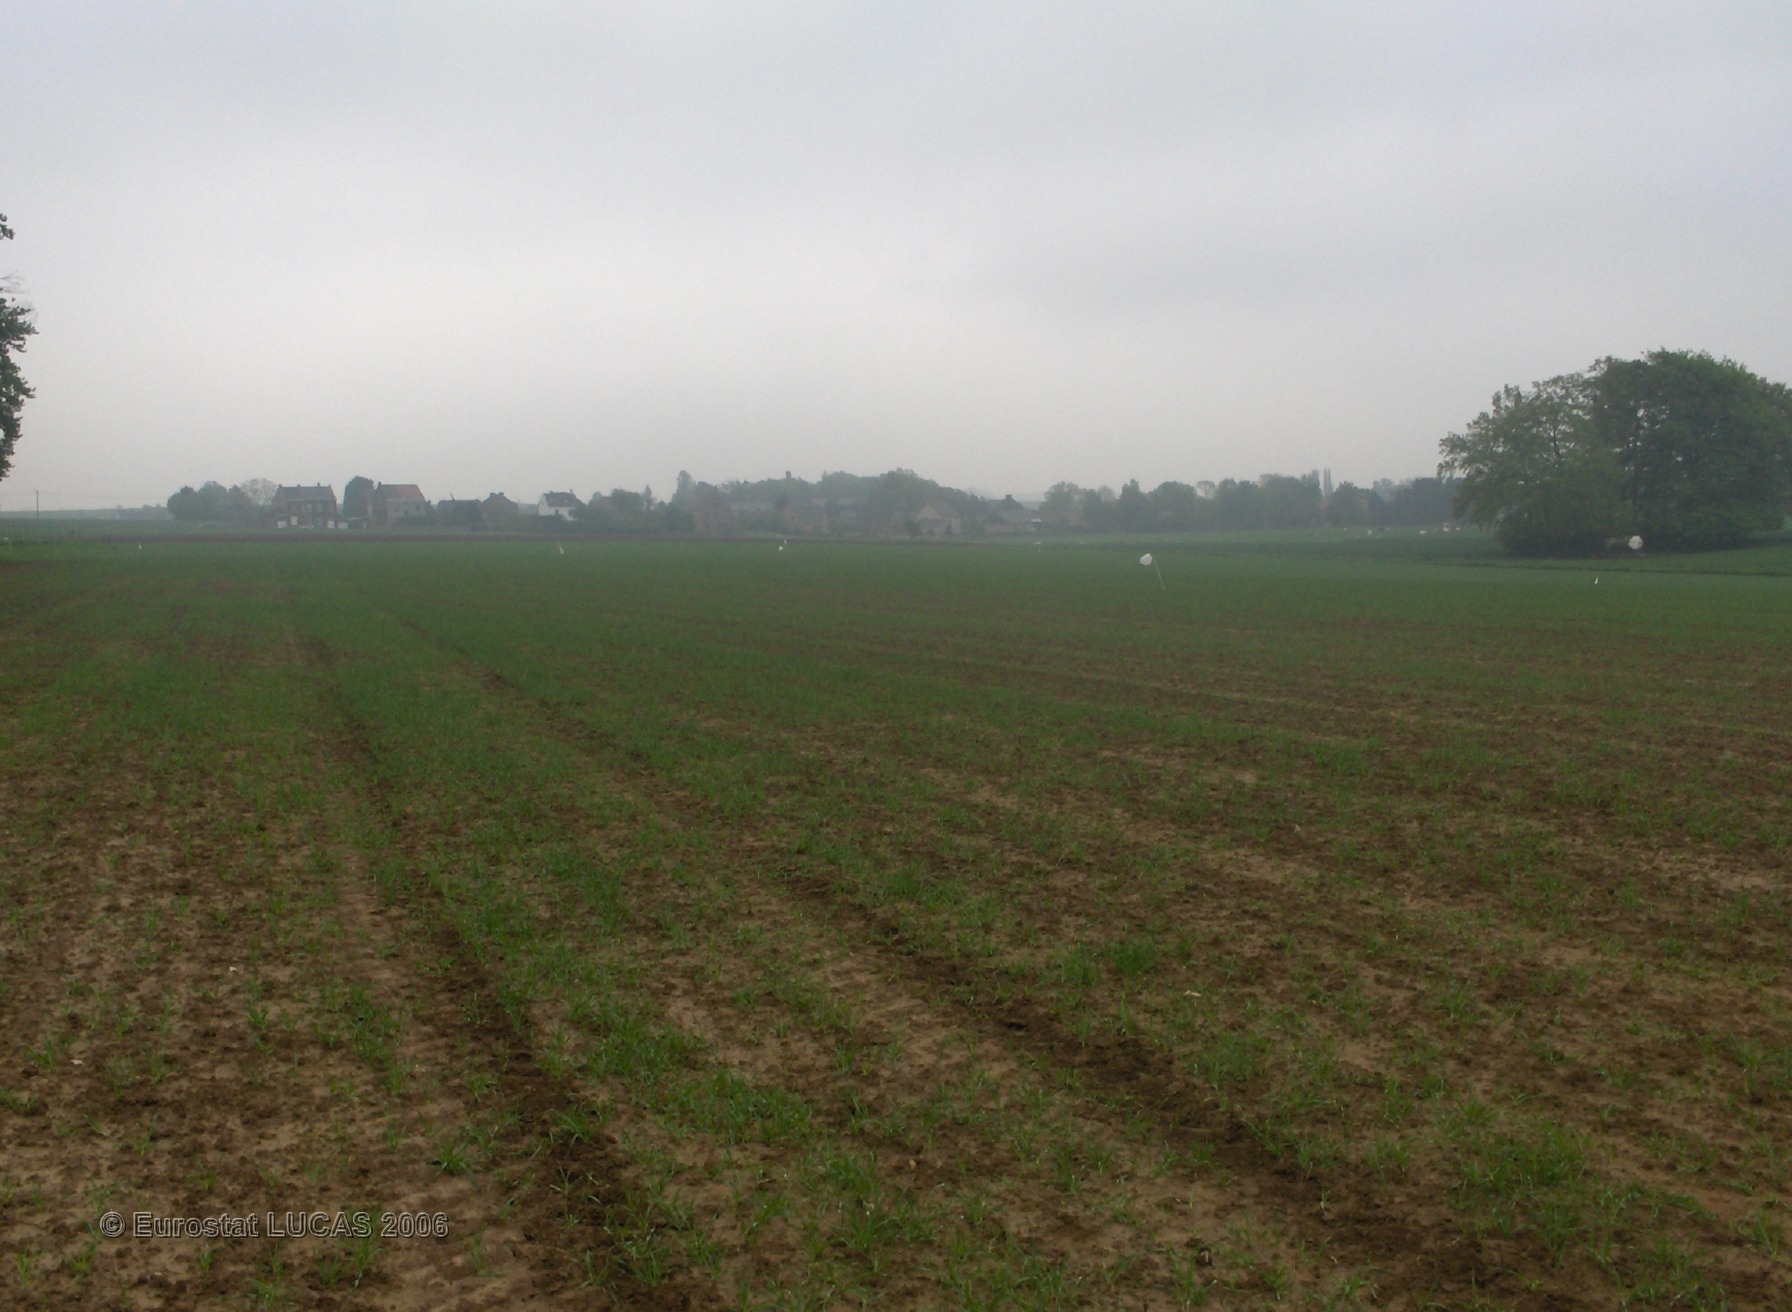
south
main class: Cropland
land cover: Barley
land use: Agriculture (excluding fallow land and kitchen gardens)
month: May
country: BE
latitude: 50.5372
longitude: 4.4790
